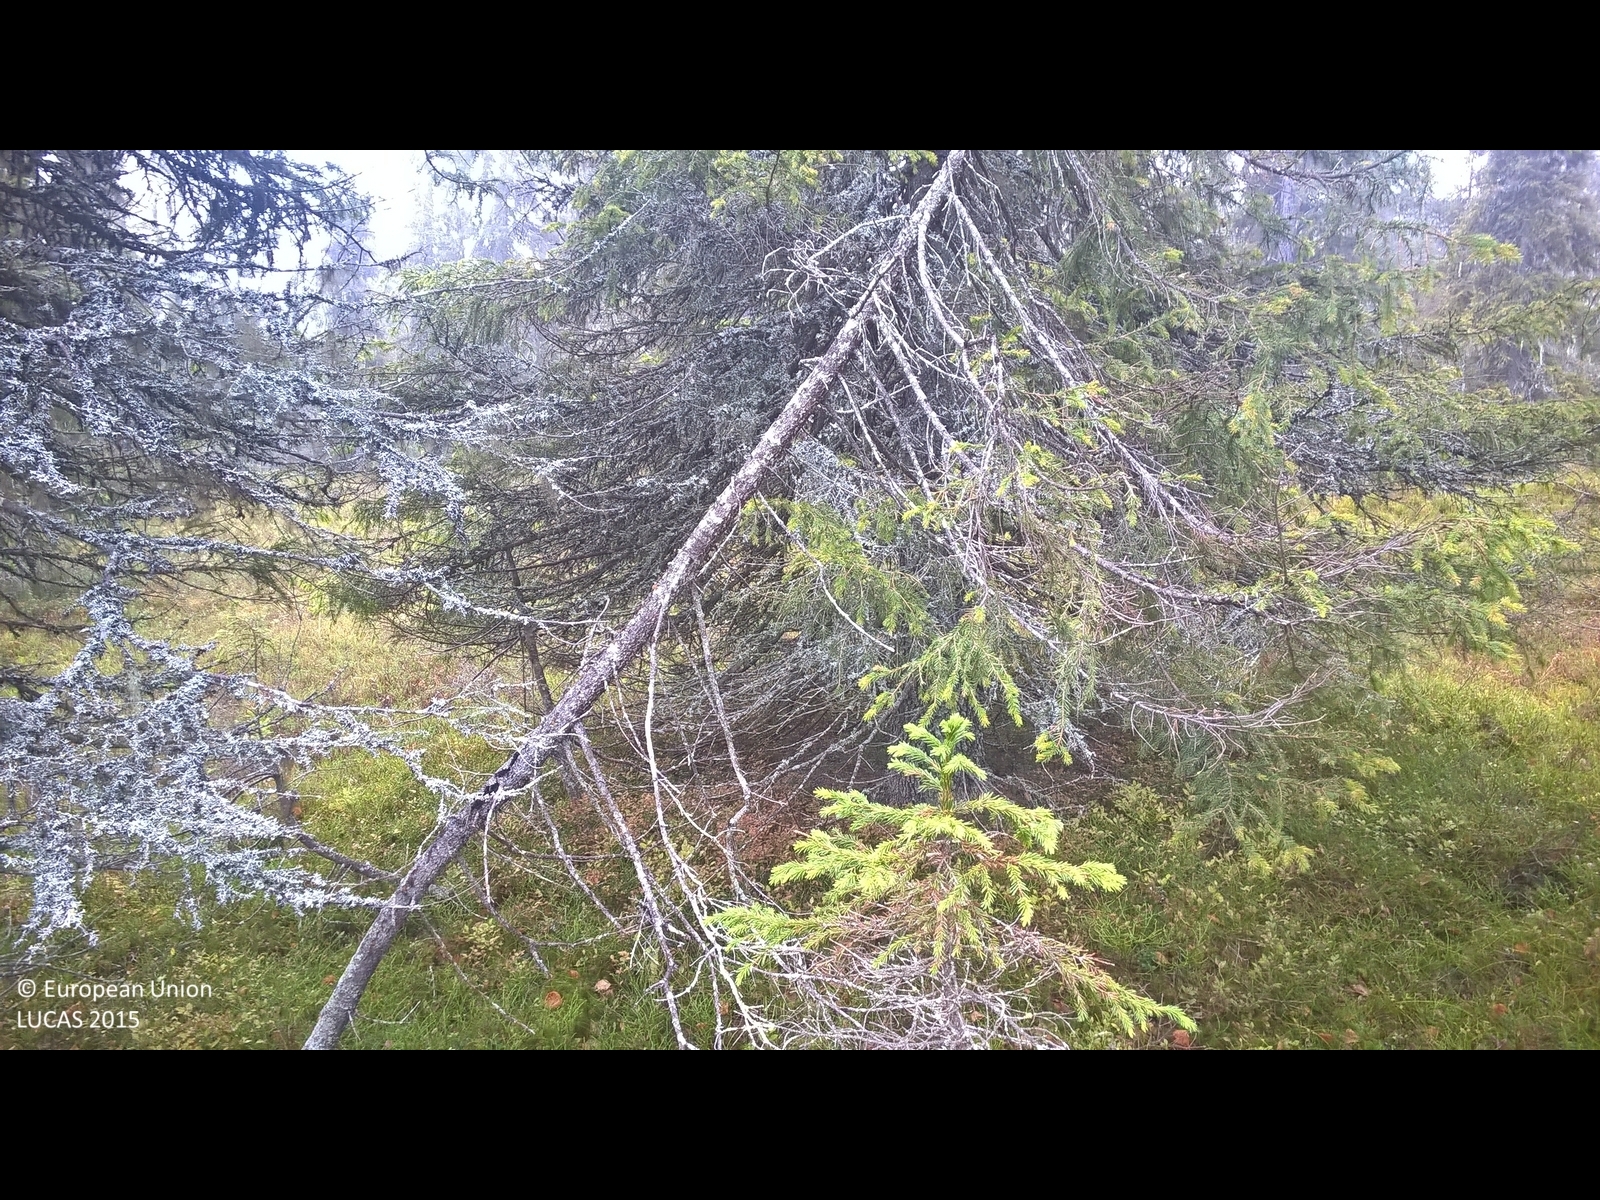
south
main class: Woodland
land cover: Spruce dominated coniferous woodland
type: boreal forest
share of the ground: > 75 %
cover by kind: coniferous forest trees 80 %, shrubs 15 %, lichens and mosses 5 %
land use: Forestry
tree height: > 5 m
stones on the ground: < 10 %
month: October
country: SE
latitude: 65.6458
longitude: 18.8044
